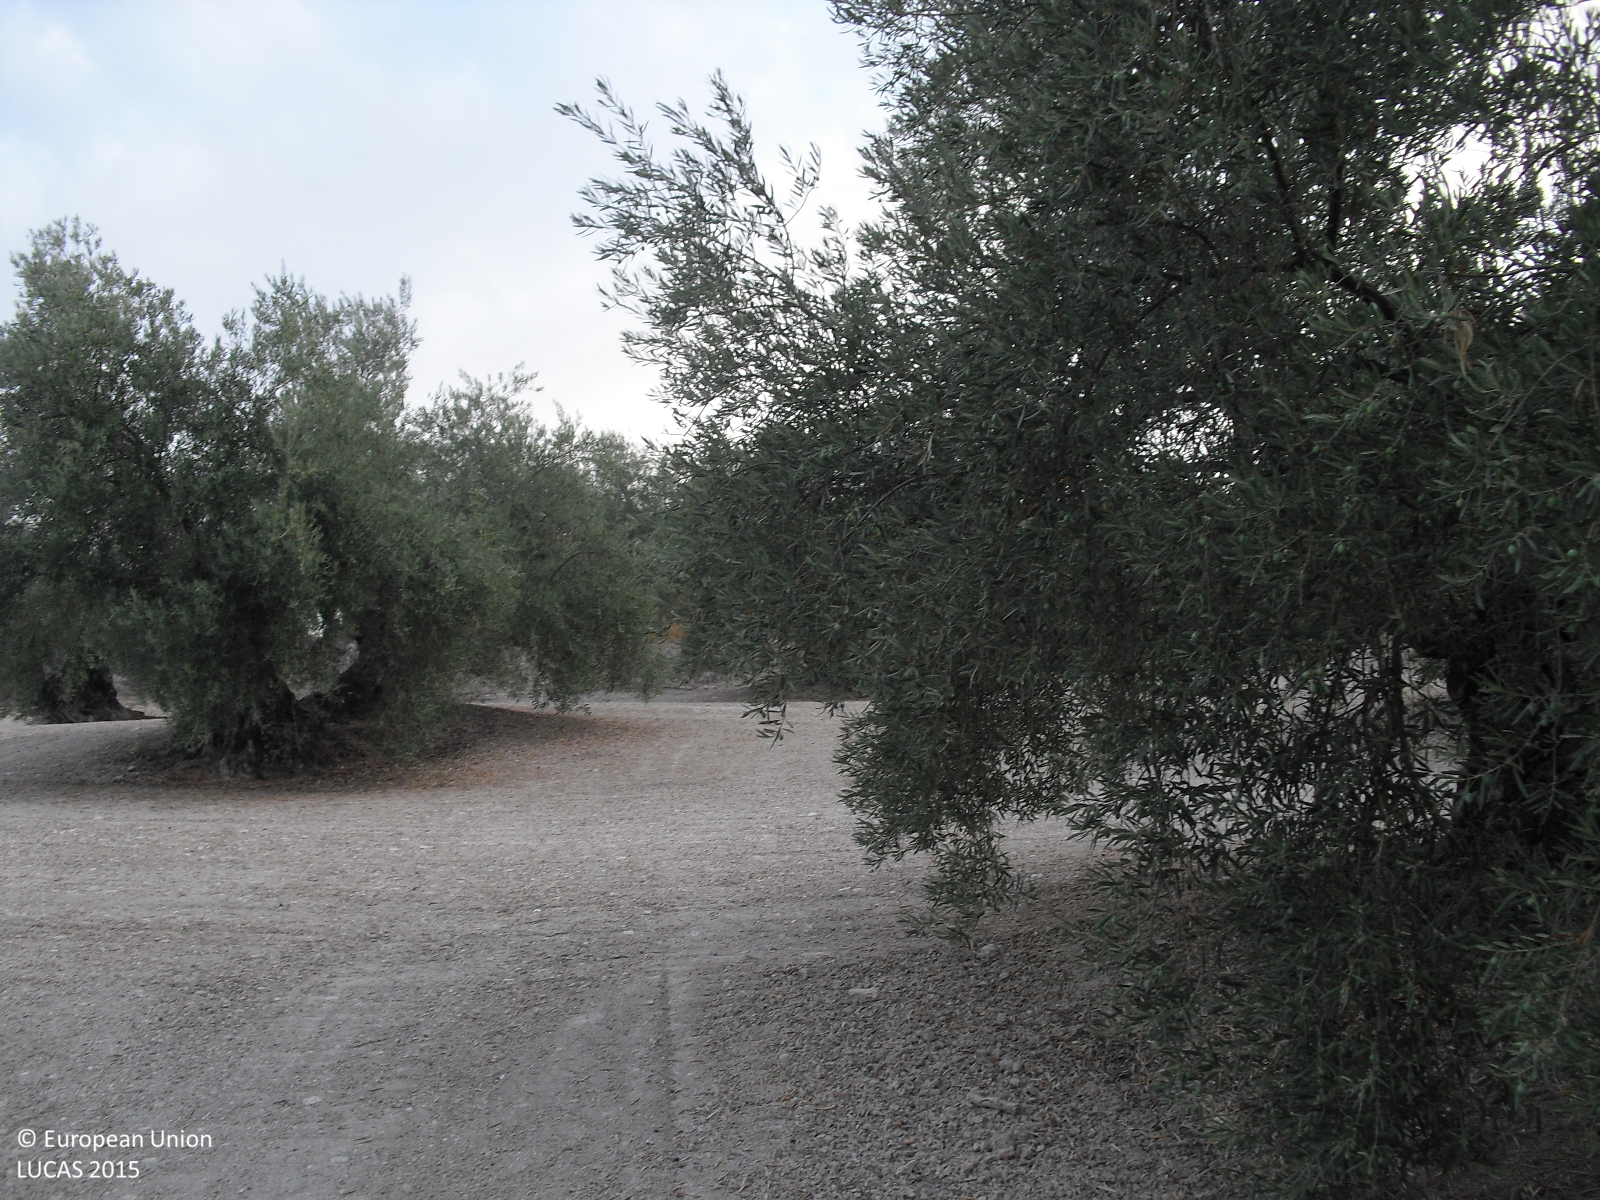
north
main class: Cropland
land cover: Olive groves
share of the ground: 25 - 50 %
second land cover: Other bare soil
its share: > 75 %
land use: Agriculture (excluding fallow land and kitchen gardens)
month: August
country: ES
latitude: 37.2984
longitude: -4.3374
